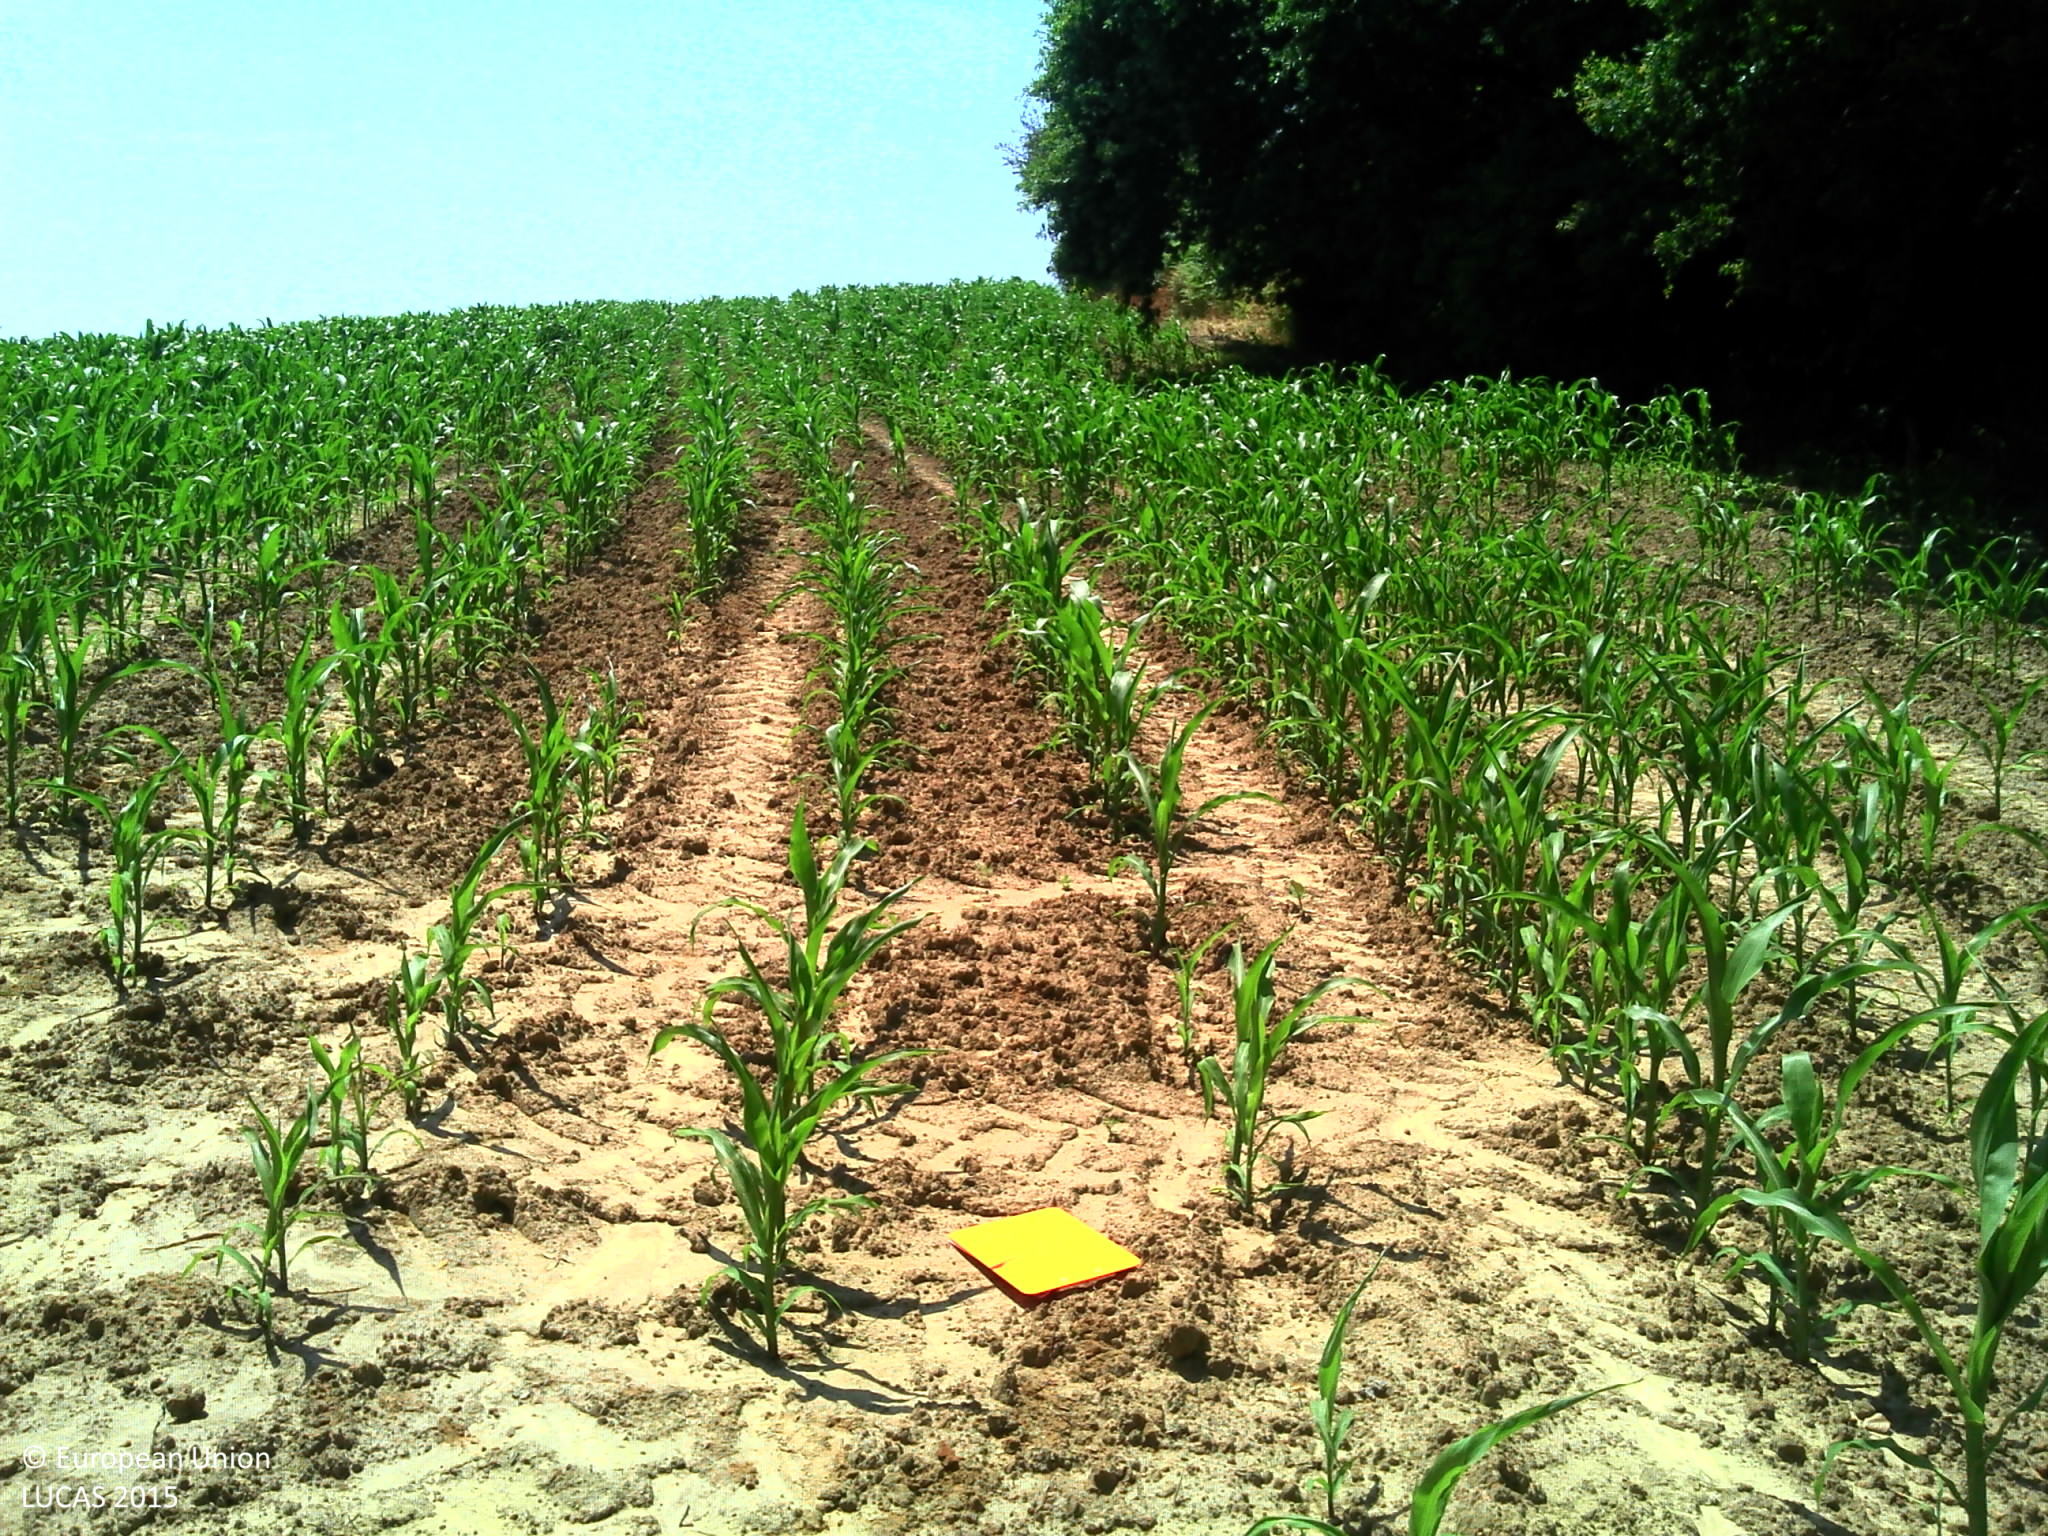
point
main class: Cropland
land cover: Maize
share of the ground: 50 - 75 %
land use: Agriculture (excluding fallow land and kitchen gardens)
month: June
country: FR
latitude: 45.7670
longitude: -0.9704
